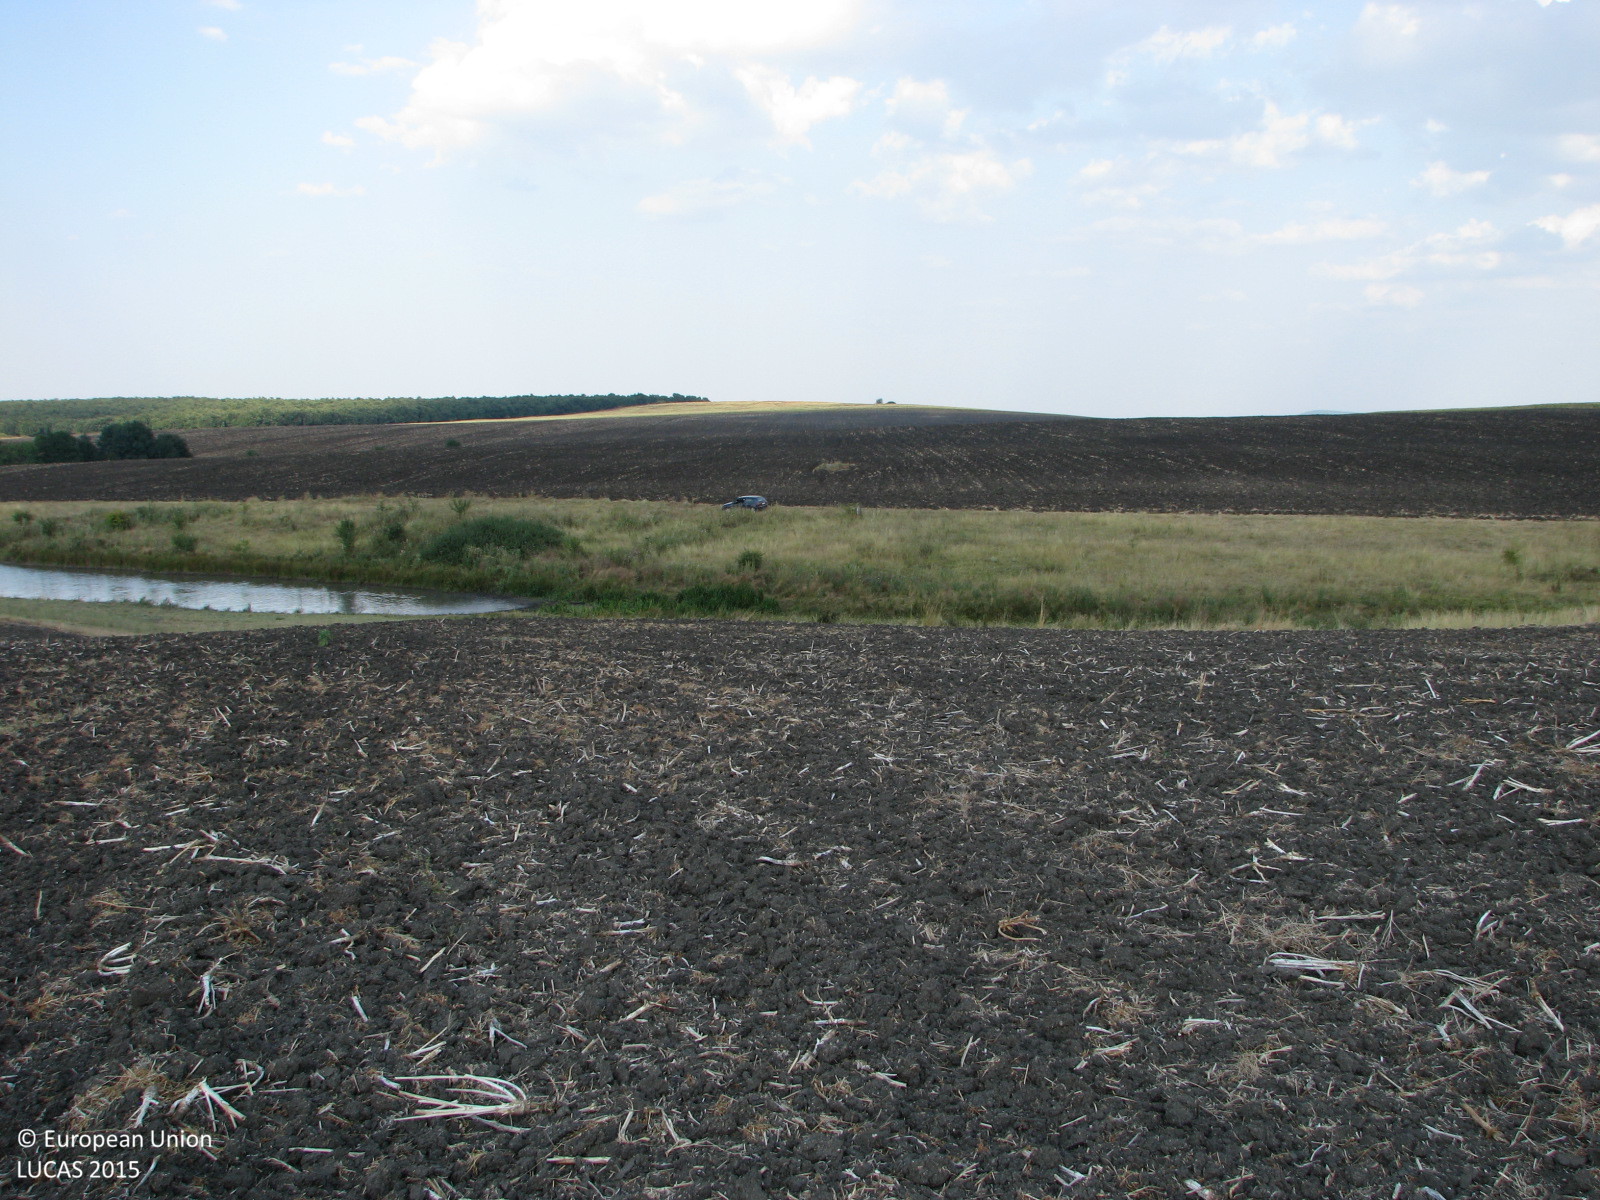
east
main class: Cropland
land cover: Other non-permanent industrial crops
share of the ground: < 10 %
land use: Agriculture (excluding fallow land and kitchen gardens)
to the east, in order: Other non-permanent industrial crops; Spontaneously vegetated surfaces; Ditches and canals; Spontaneously vegetated surfaces; Tracks; Common wheat
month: August
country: BG
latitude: 42.1618
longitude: 26.7854
